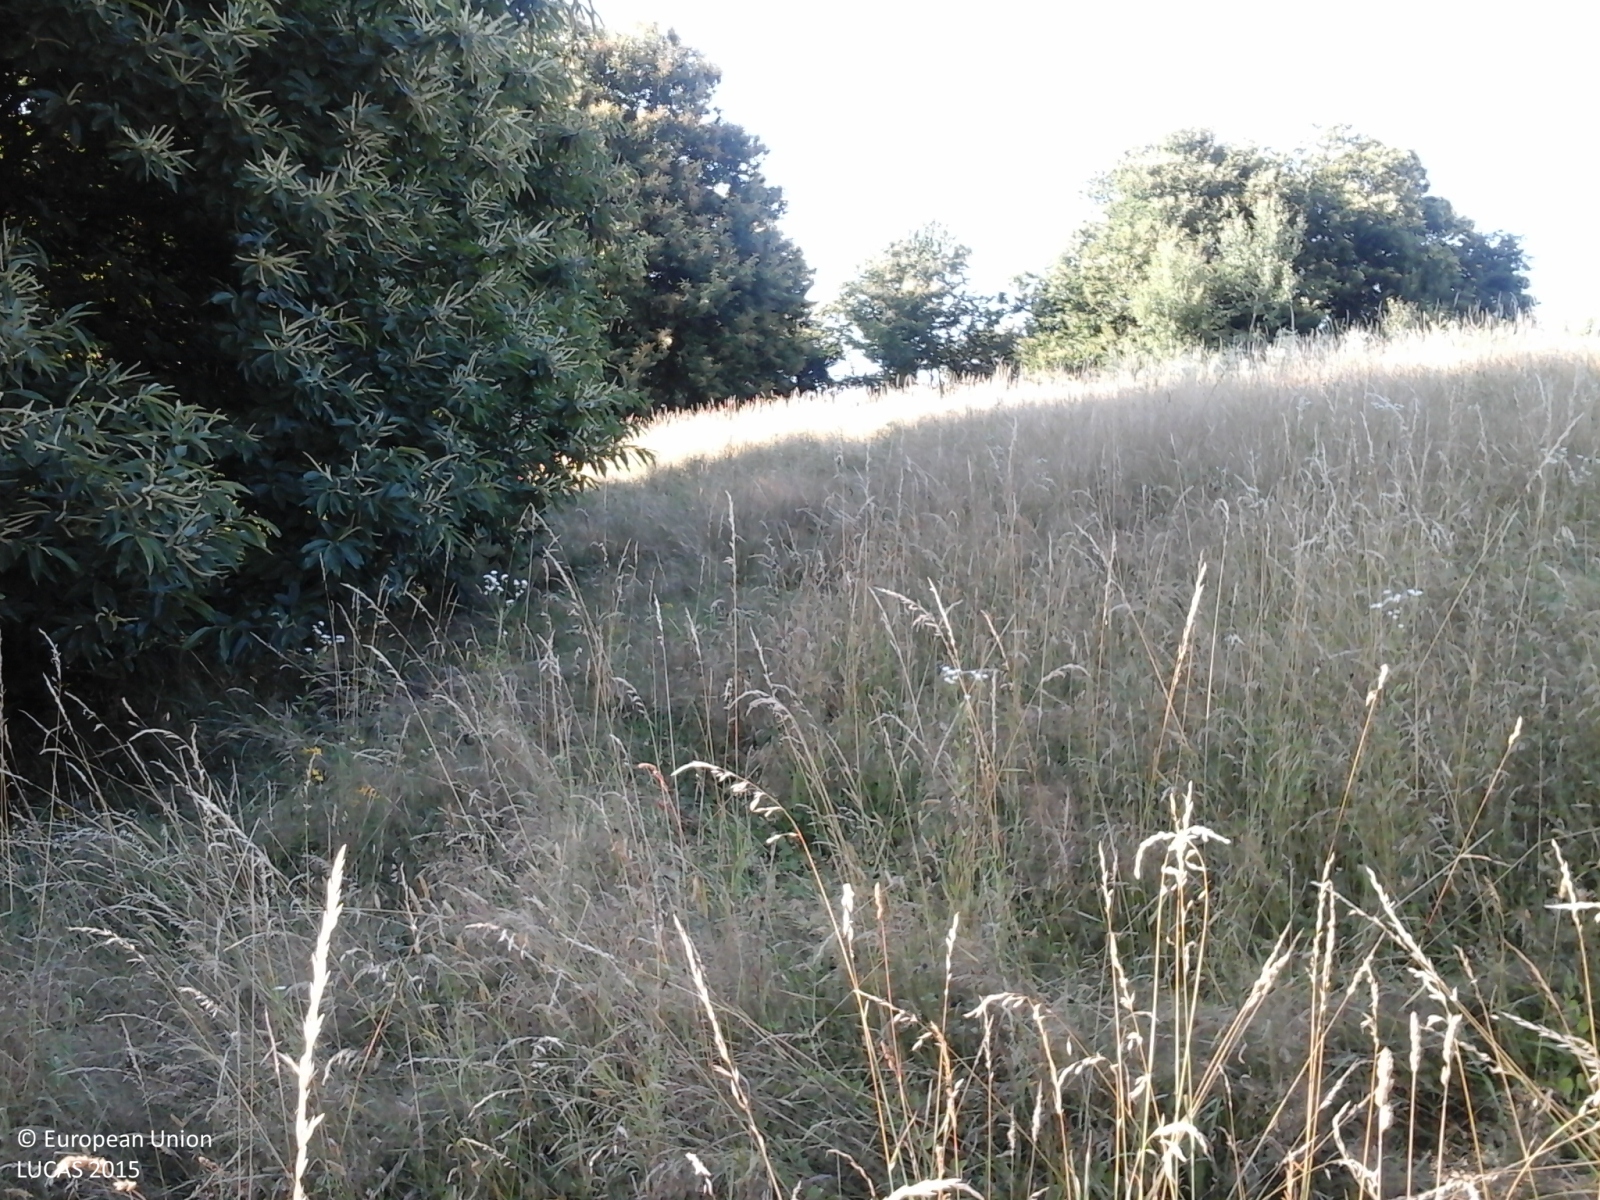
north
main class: Grassland
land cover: Grassland without tree/shrub cover
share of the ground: > 75 %
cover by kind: herbaceous plants 100 %
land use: Agriculture (excluding fallow land and kitchen gardens)
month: June
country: IT
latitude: 44.3460
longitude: 7.8346
